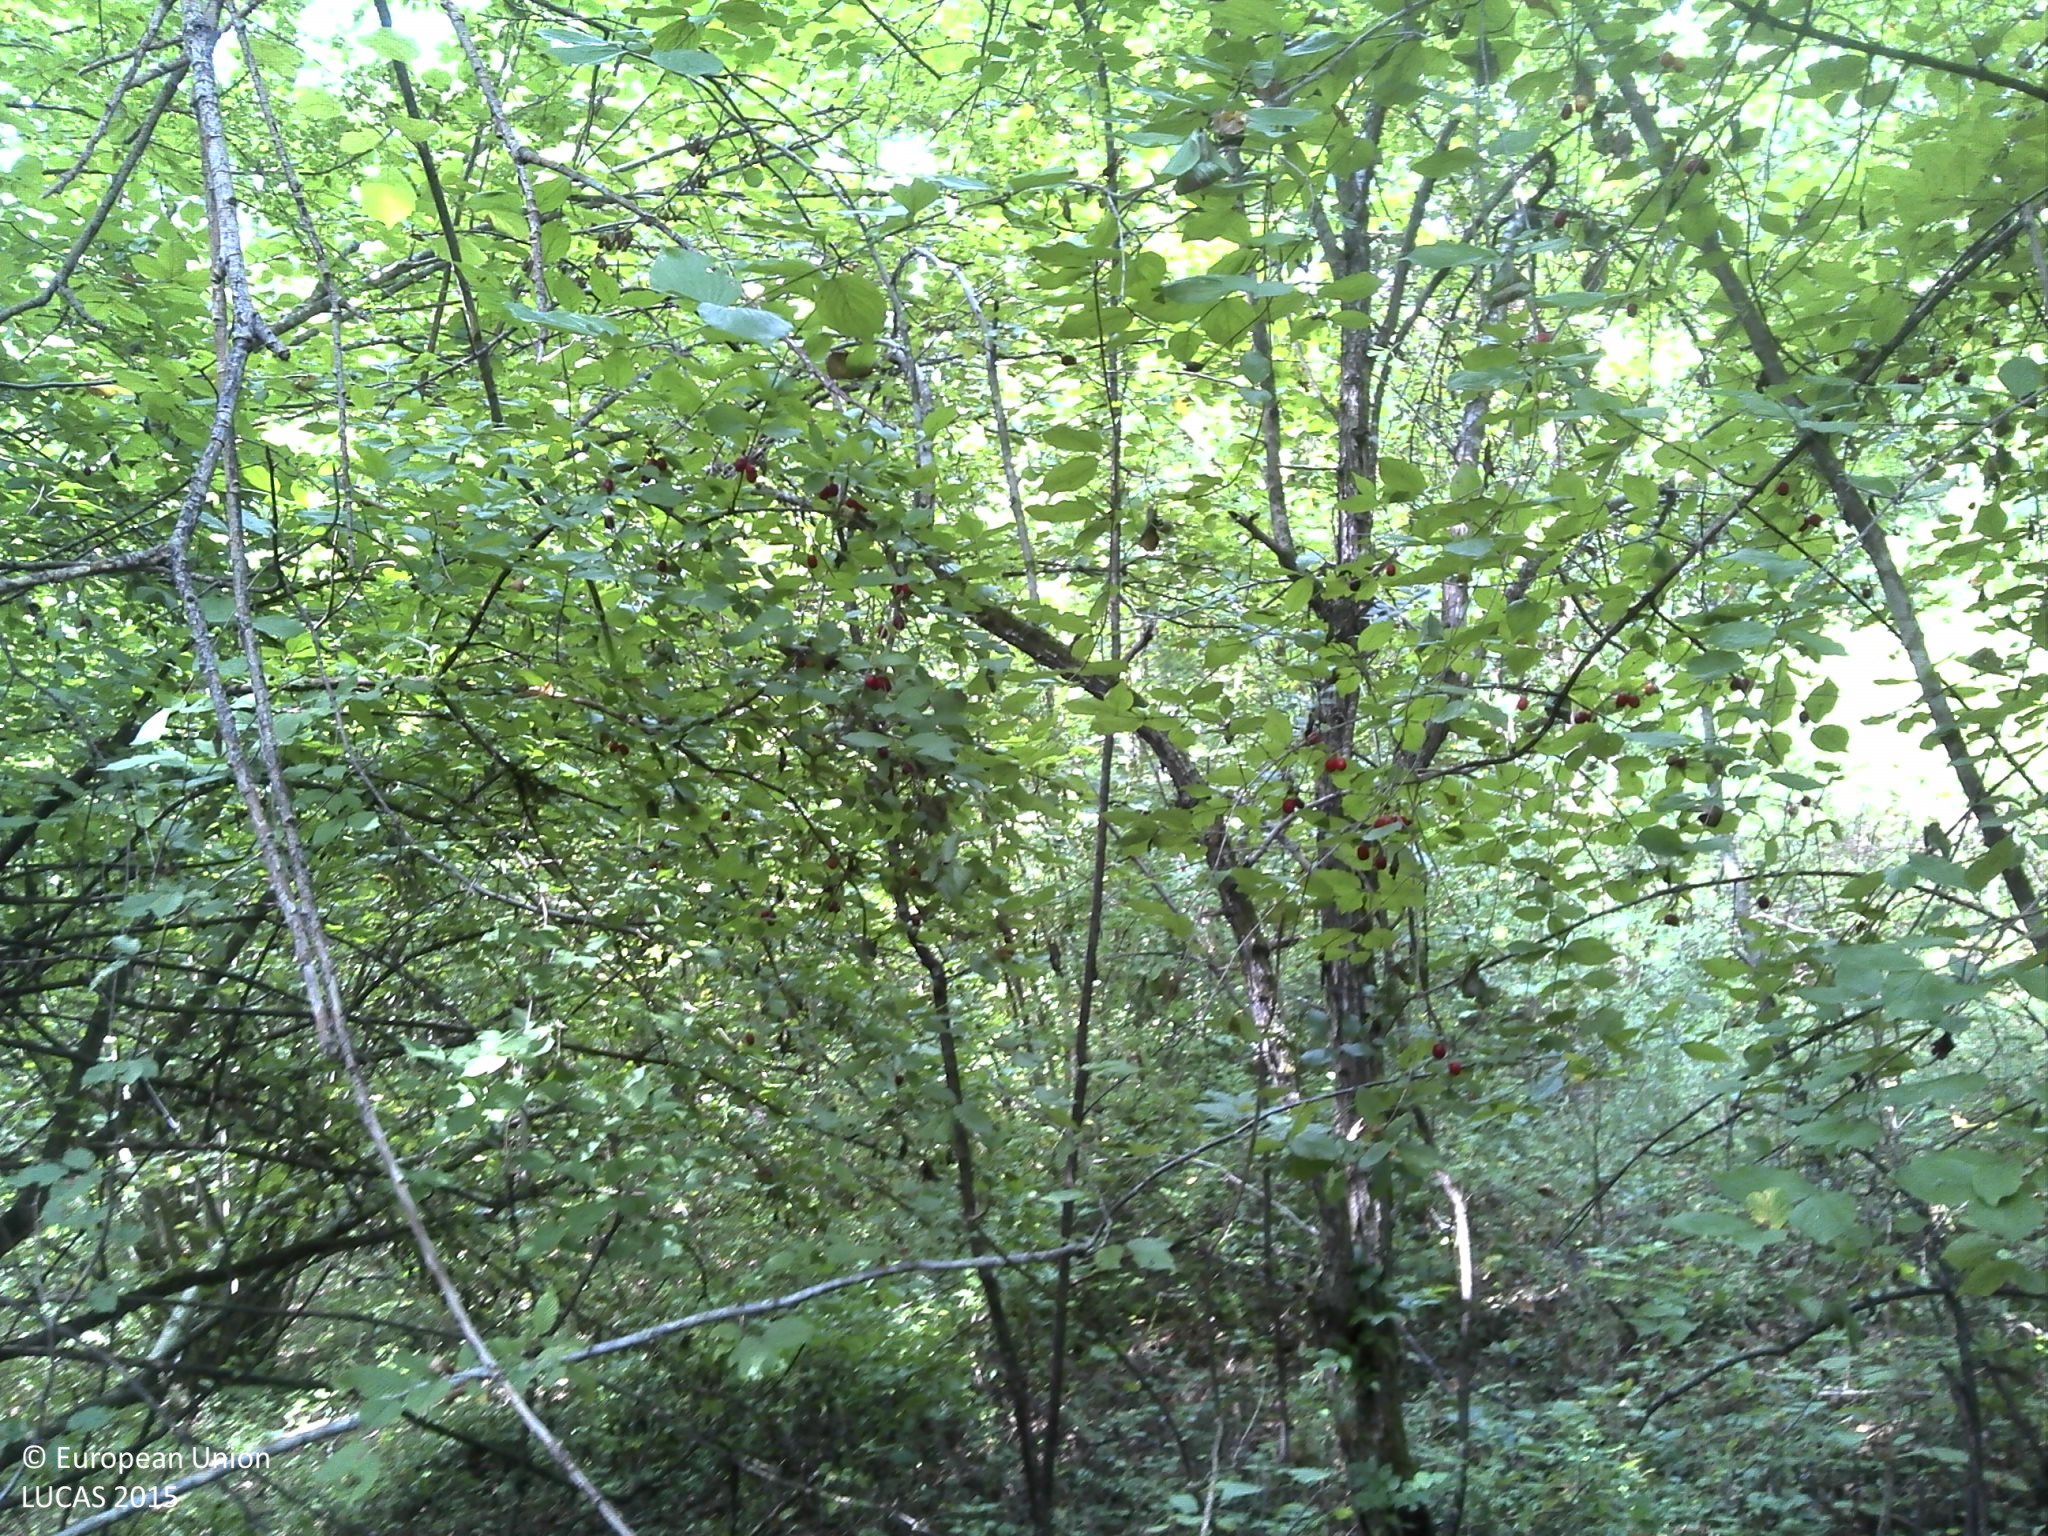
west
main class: Woodland
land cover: Broadleaved woodland
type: beech forest
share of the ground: > 75 %
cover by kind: broadleaved forest trees 100 %
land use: Forestry
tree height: > 5 m
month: September
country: HR
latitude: 45.1748
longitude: 15.6070
